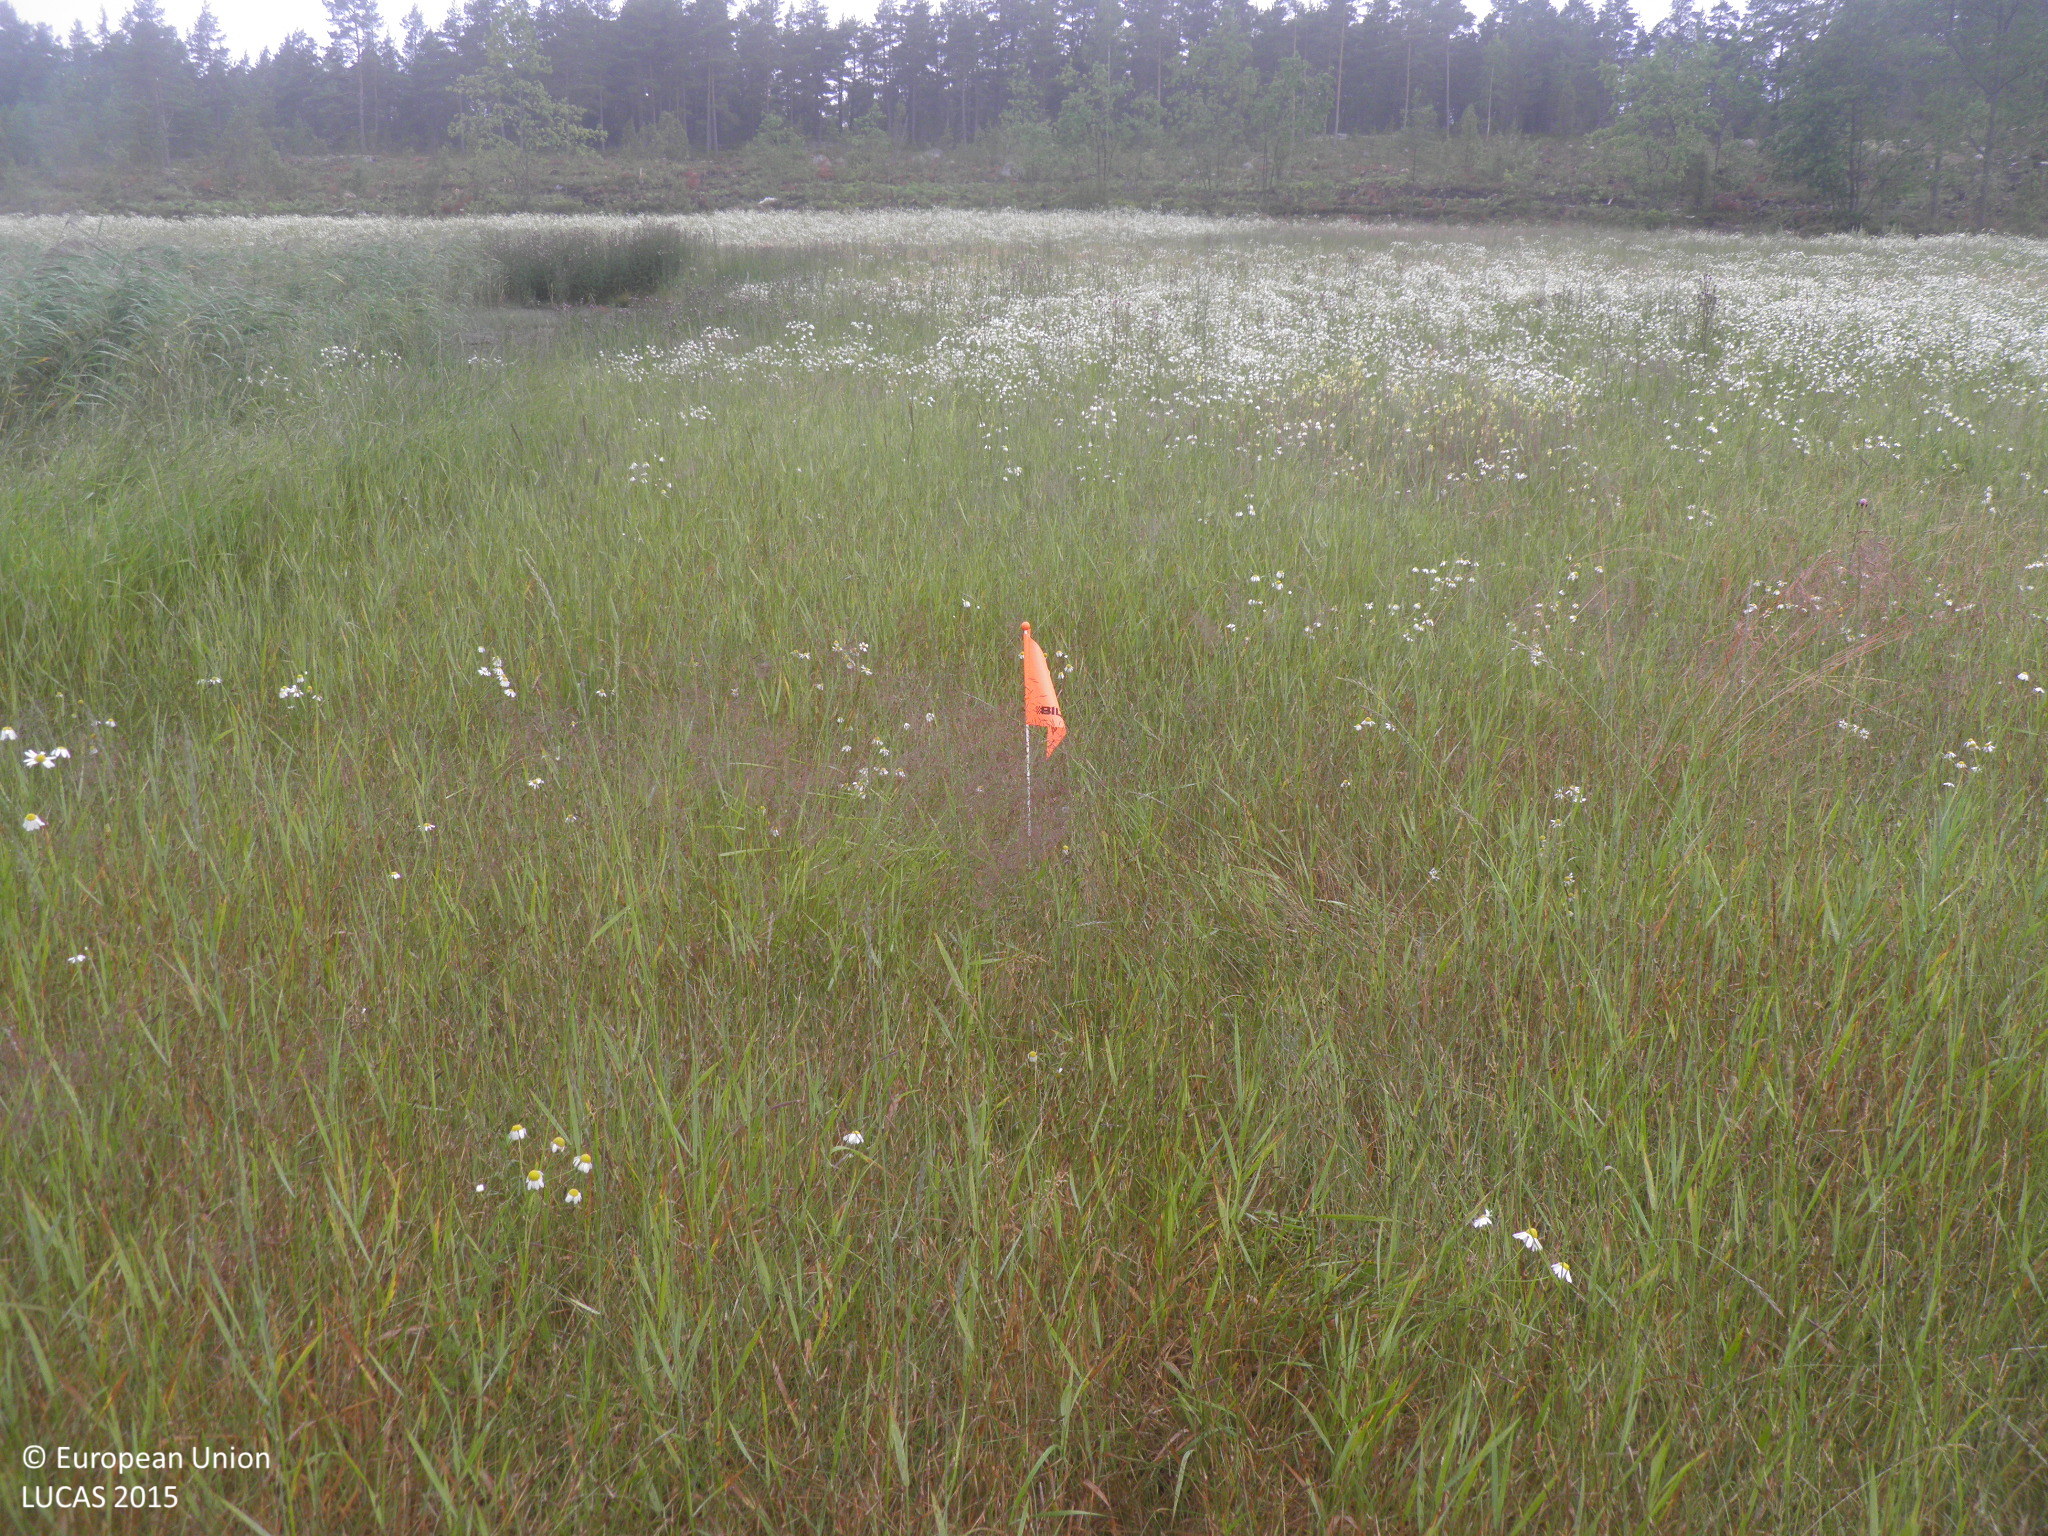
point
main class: Grassland
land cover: Grassland without tree/shrub cover
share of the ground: > 75 %
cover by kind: herbaceous plants 100 %
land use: Agriculture (excluding fallow land and kitchen gardens)
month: July
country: FI
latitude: 60.0359
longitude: 22.7677
